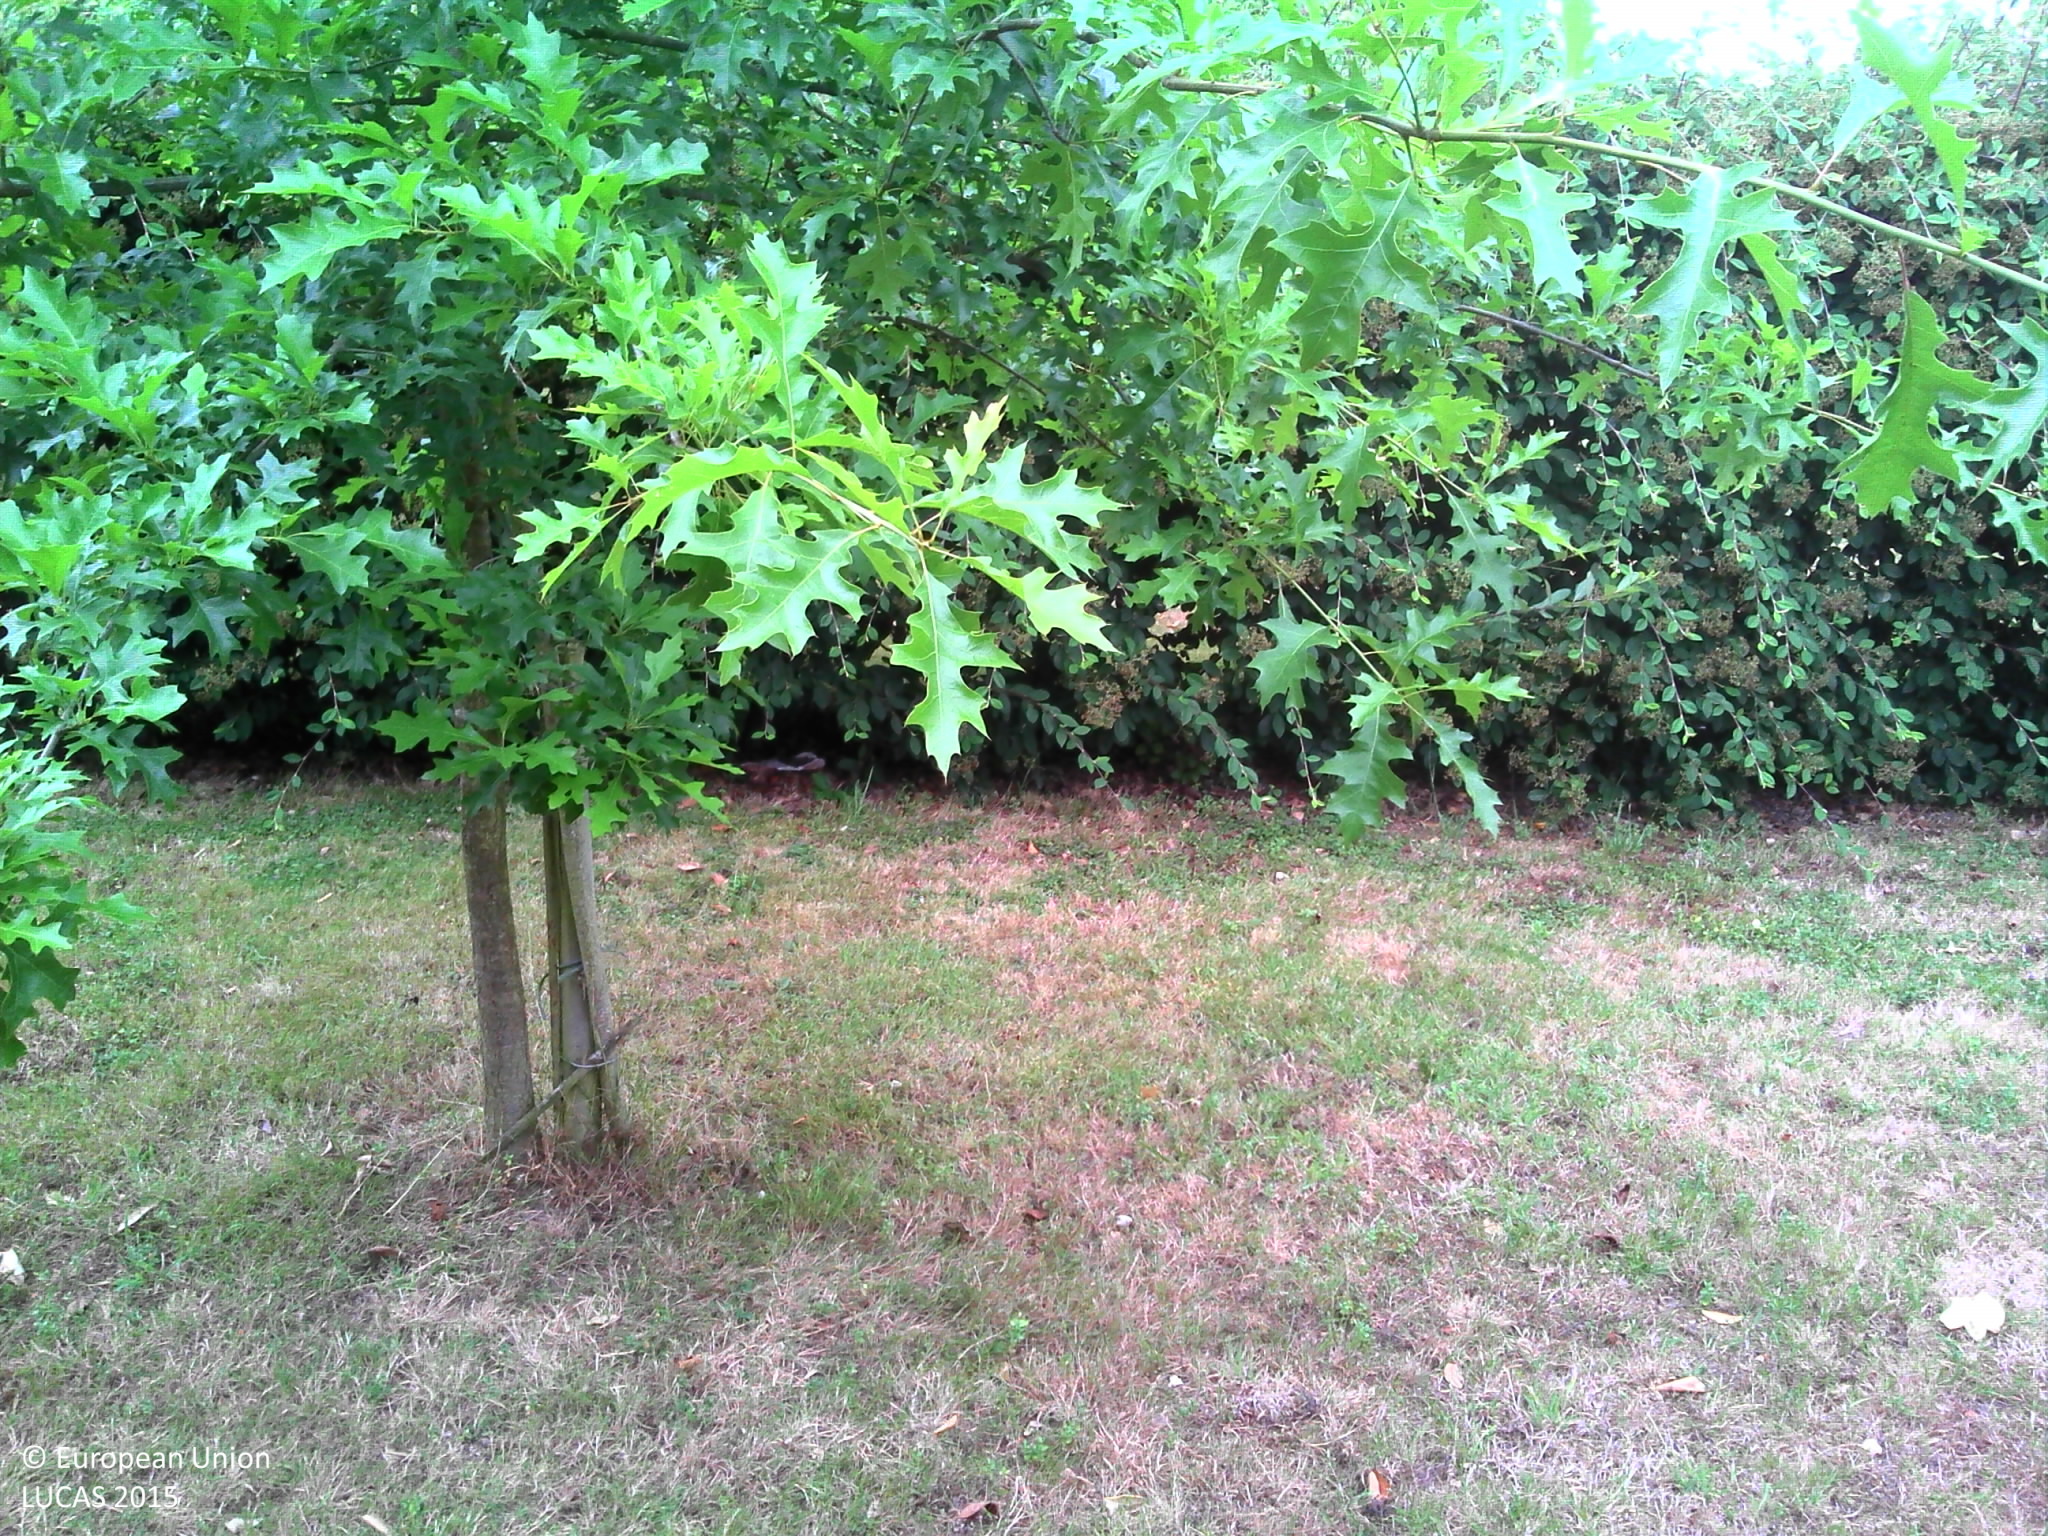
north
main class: Grassland
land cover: Grassland with sparse tree/shrub cover
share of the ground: > 75 %
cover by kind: herbaceous plants 95 %, broadleaved forest trees 5 %
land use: Residential
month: July
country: FR
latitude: 47.1449
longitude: -1.6874
